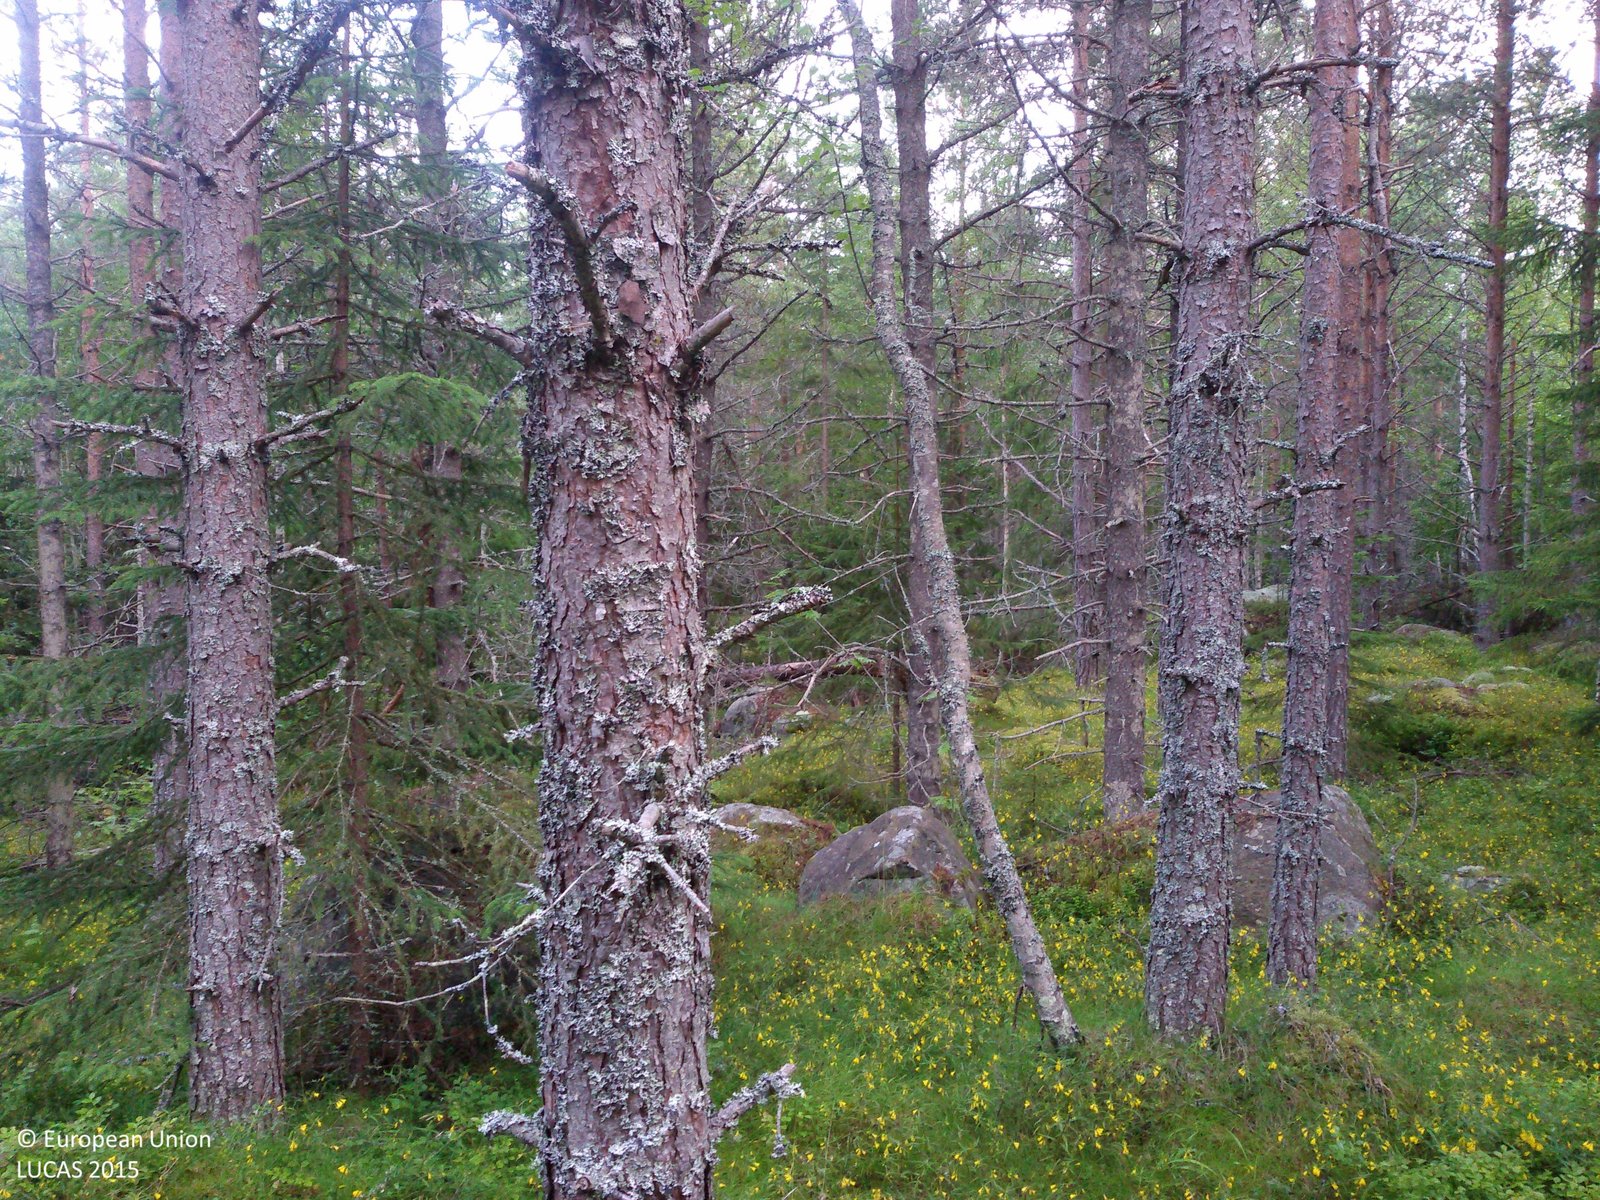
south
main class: Woodland
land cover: Pine dominated coniferous woodland
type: boreal forest
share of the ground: > 75 %
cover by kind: coniferous forest trees 70 %, herbaceous plants 25 %, broadleaved forest trees 5 %
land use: Forestry
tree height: > 5 m
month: August
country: SE
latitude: 60.8937
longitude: 16.6031
